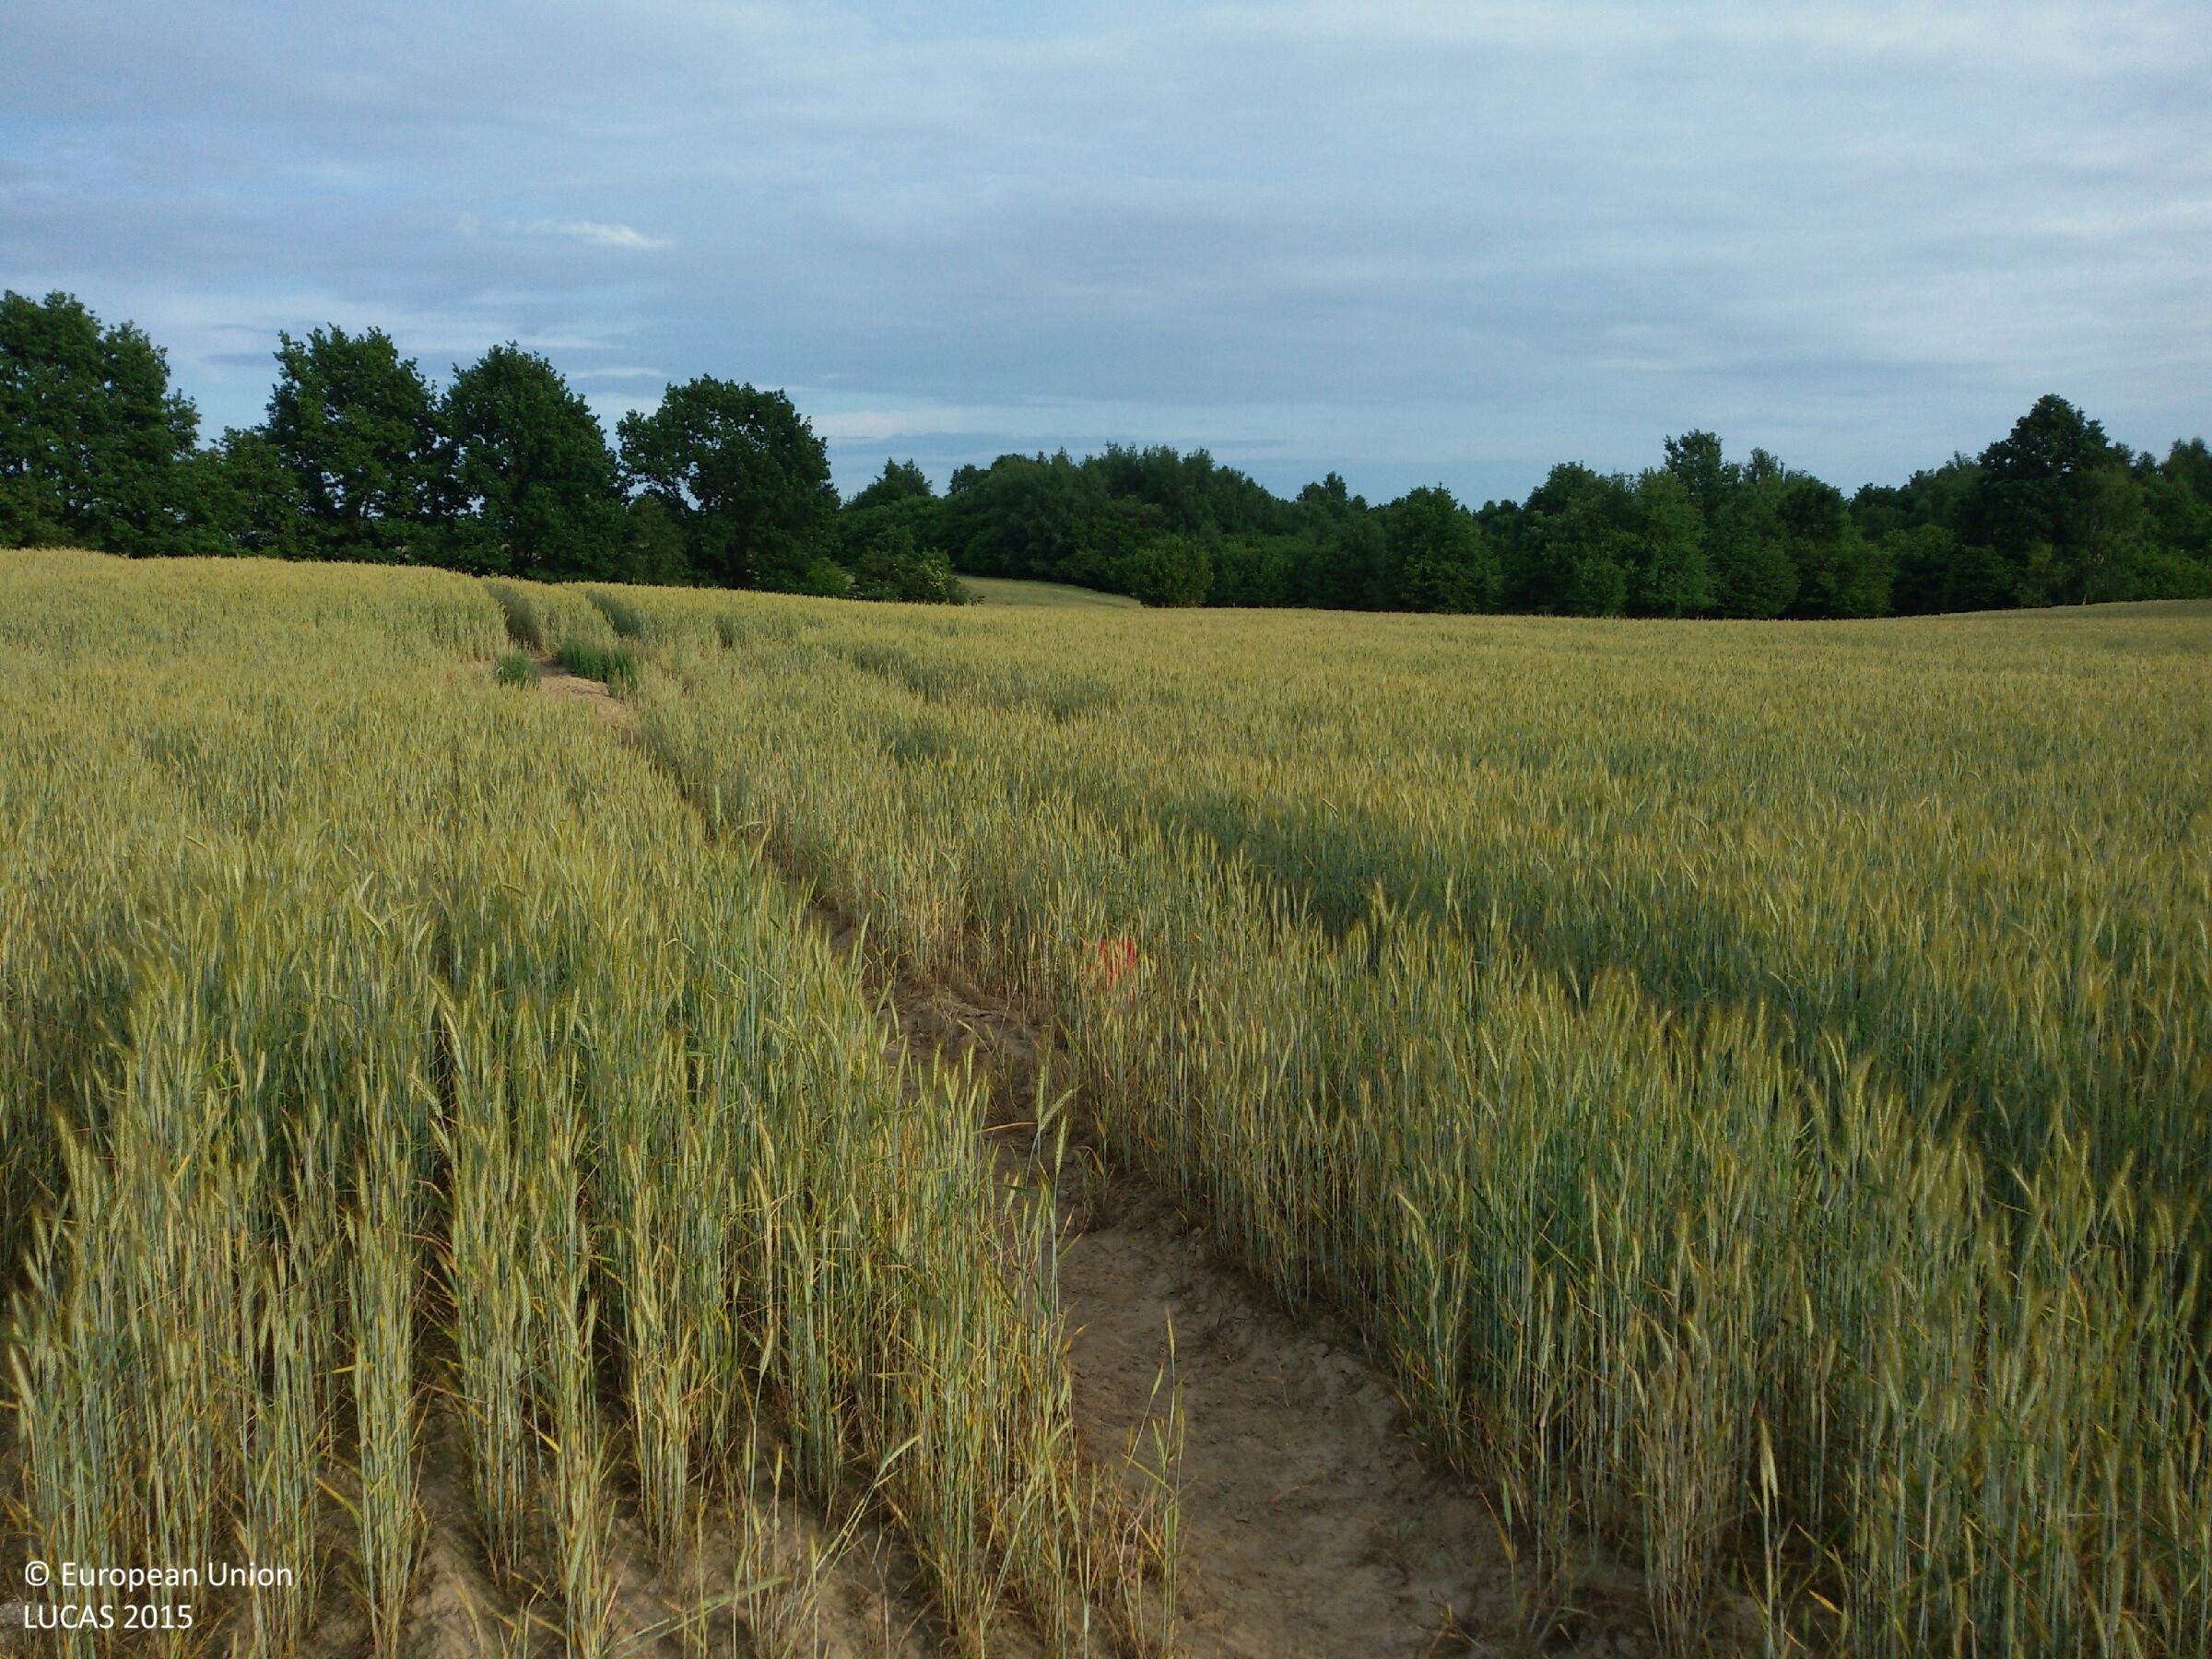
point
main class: Cropland
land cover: Common wheat
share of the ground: > 75 %
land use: Agriculture (excluding fallow land and kitchen gardens)
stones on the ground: < 10 %
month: June
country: PL
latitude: 53.4468
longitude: 20.1362
